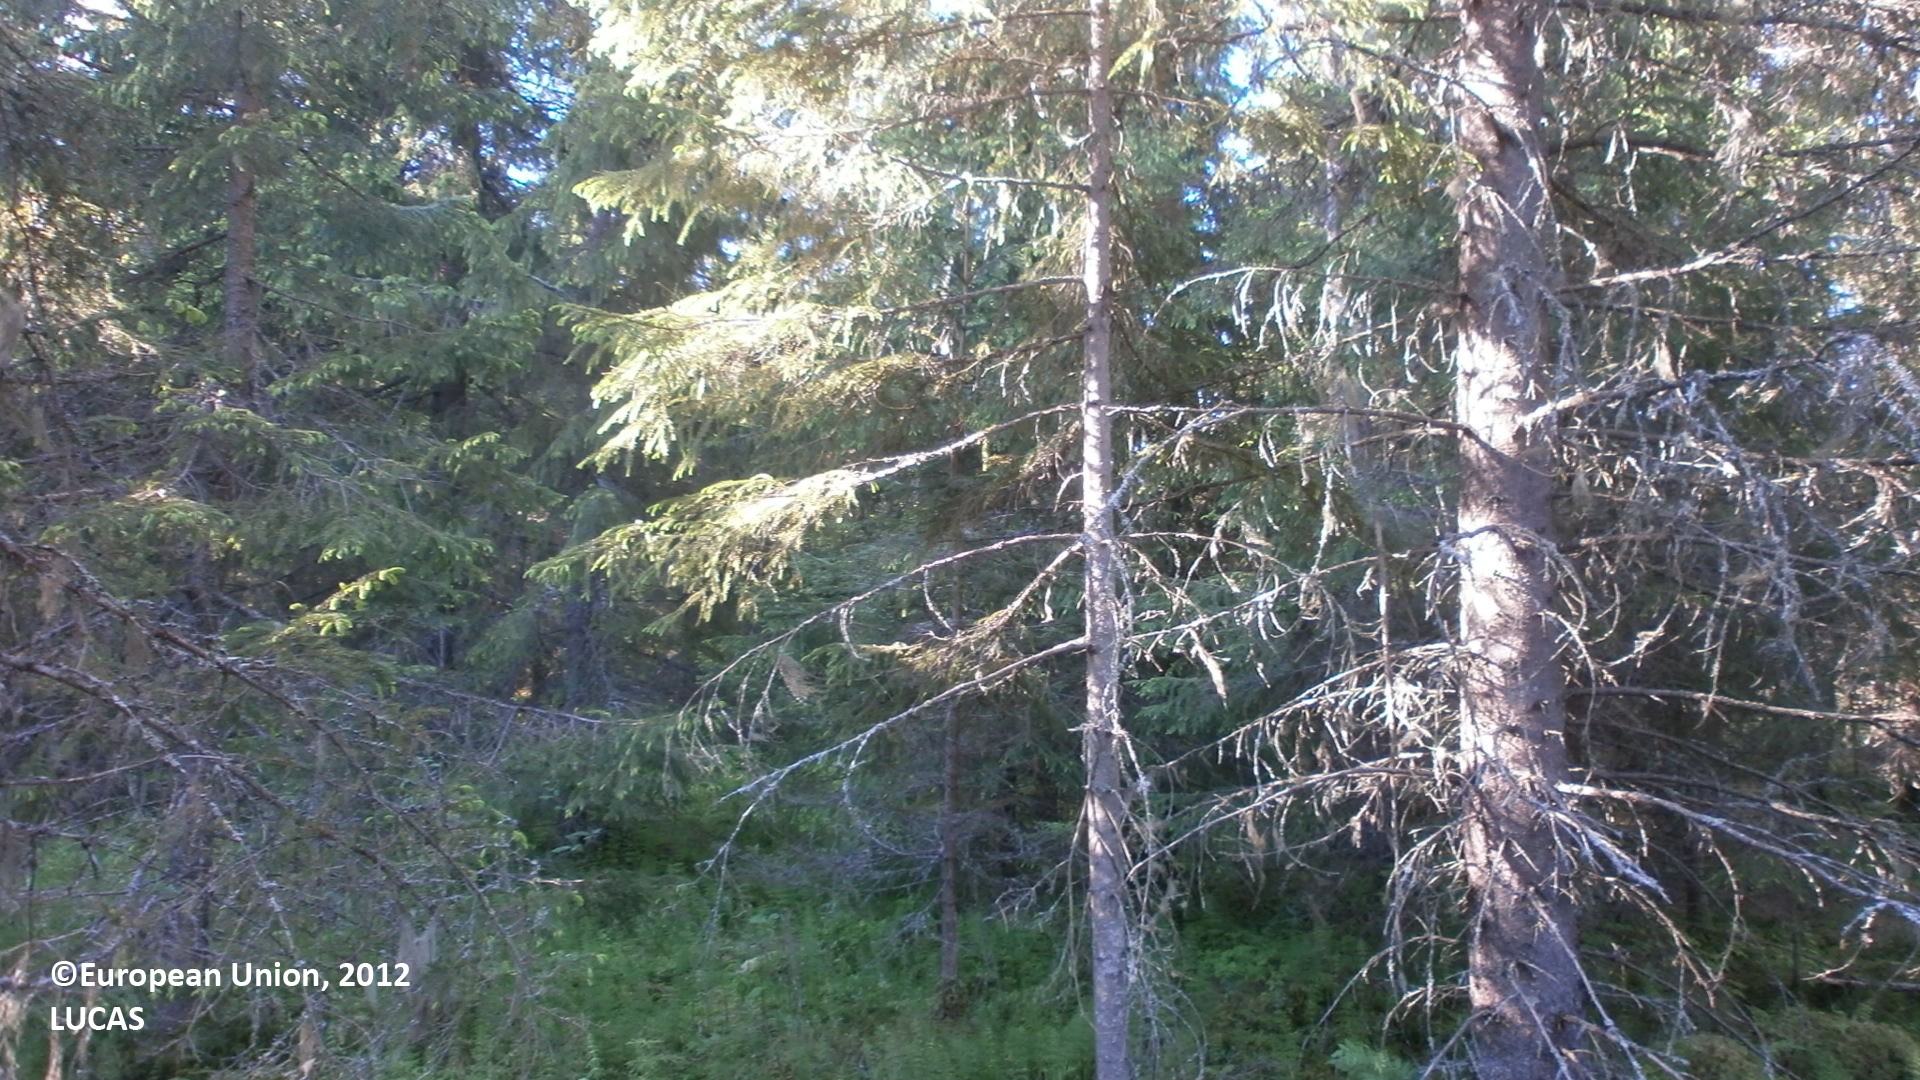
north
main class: Woodland
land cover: Spruce dominated coniferous woodland
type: mire and swamp forests
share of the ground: 50 - 75 %
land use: Forestry
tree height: > 5 m
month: June
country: FI
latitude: 64.0853
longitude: 25.7485
